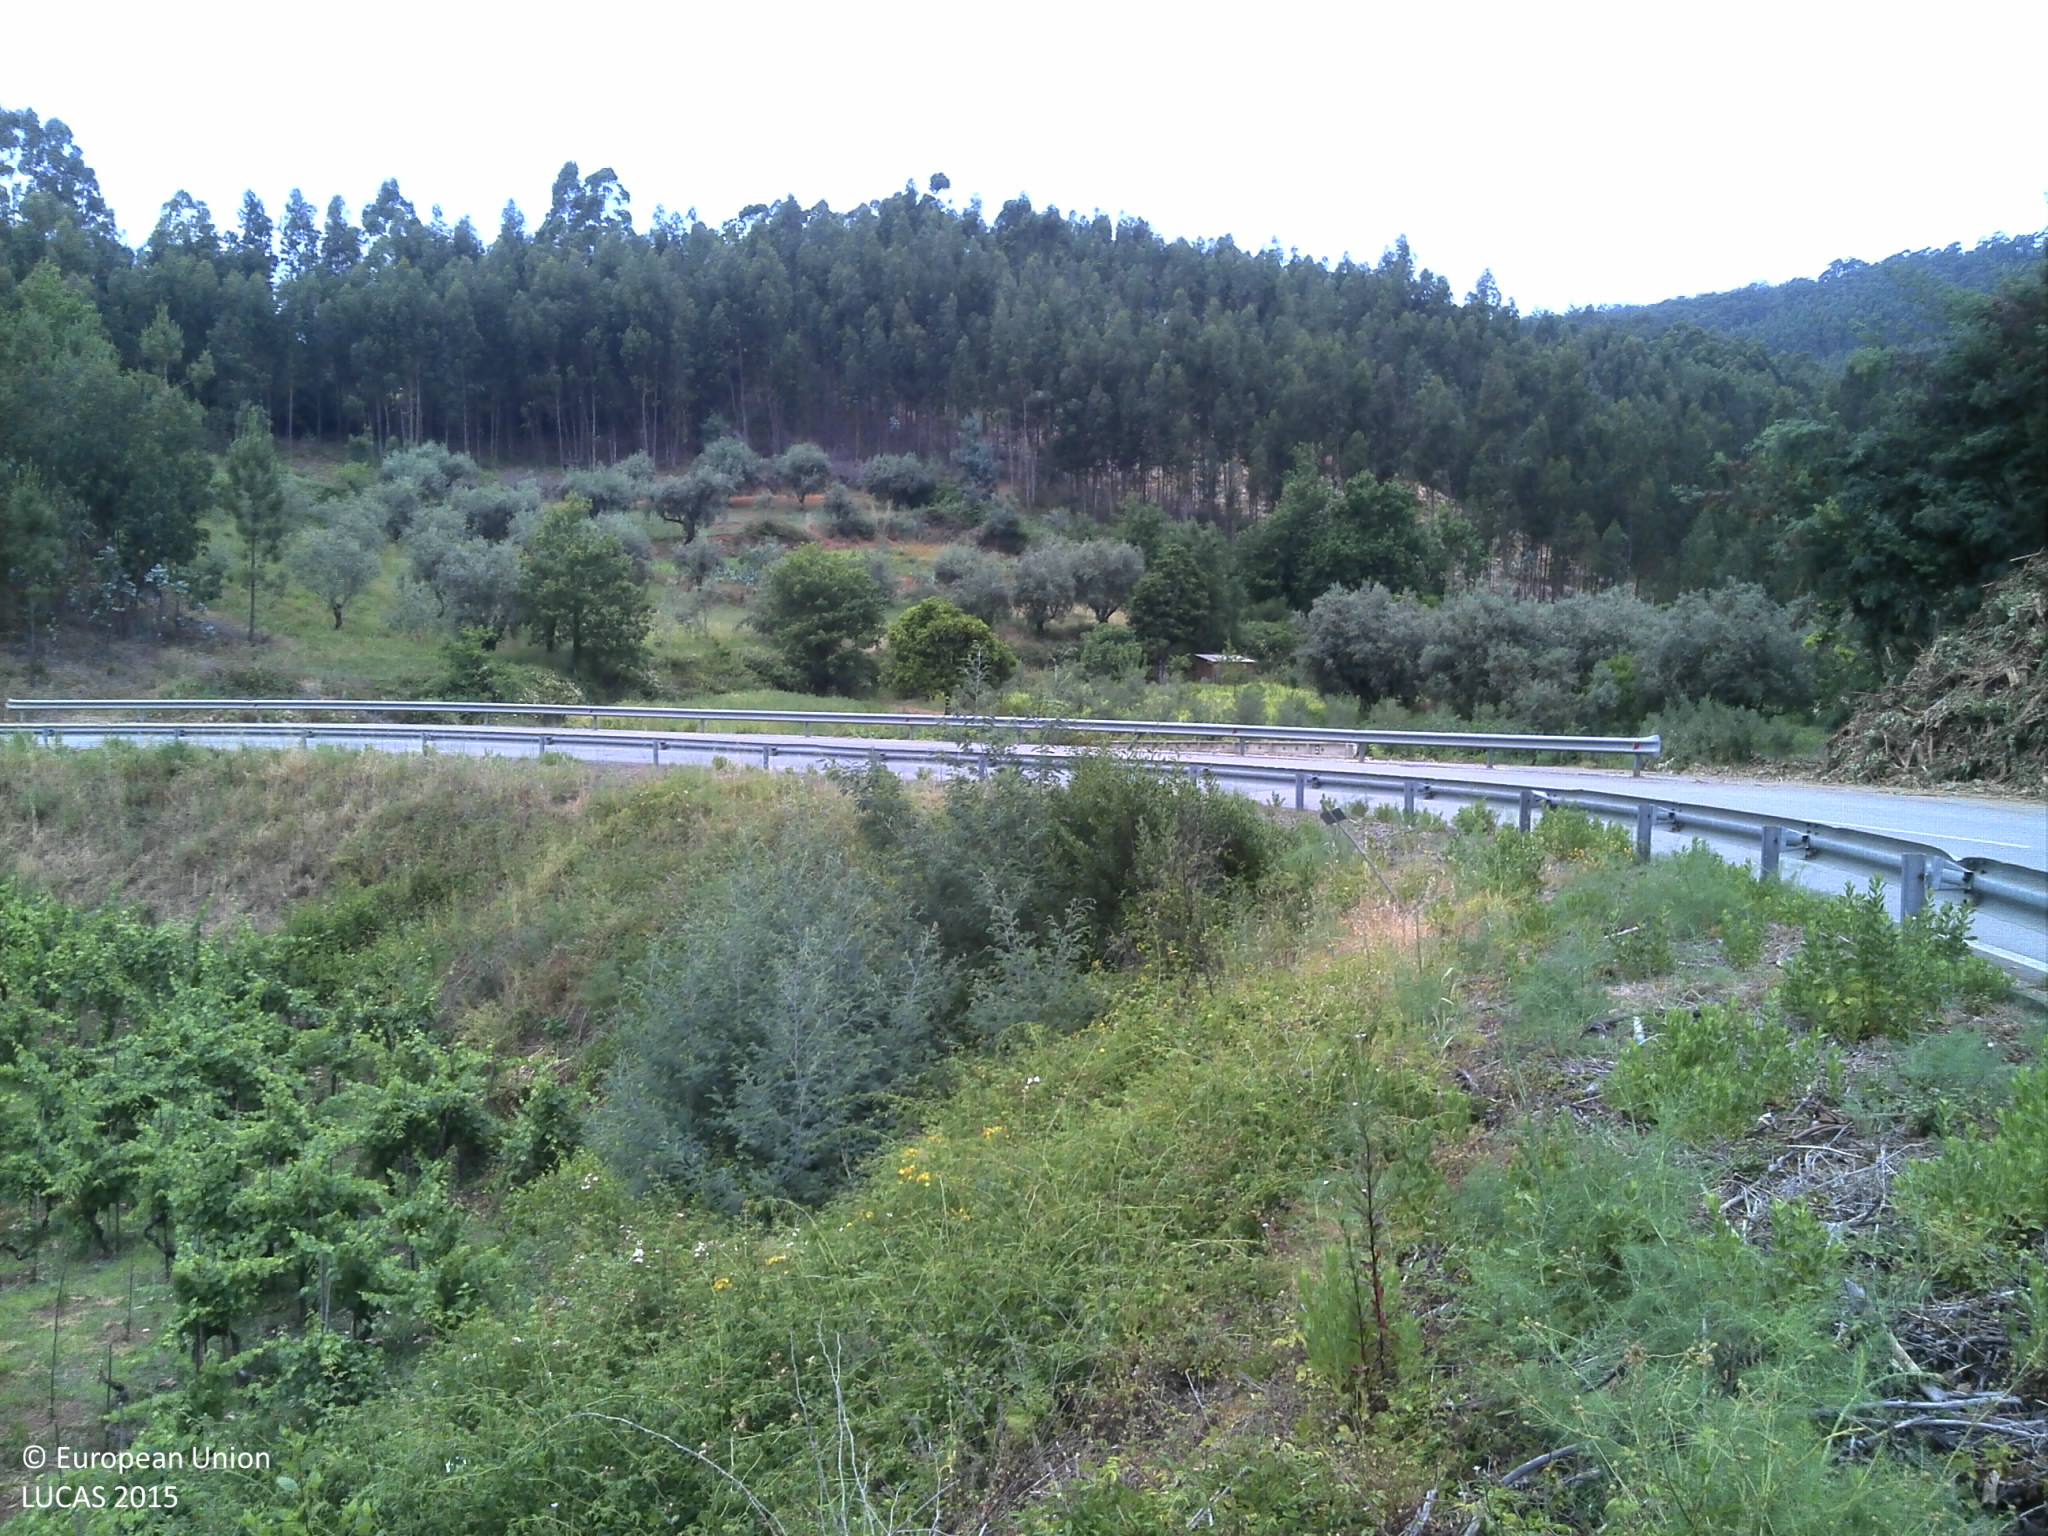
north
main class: Shrubland
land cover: Shrubland without tree cover
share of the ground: > 75 %
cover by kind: shrubs 80 %, unconsolidated bare surface 15 %, herbaceous plants 5 %
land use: Semi-natural and natural areas not in use
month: June
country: PT
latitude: 40.3165
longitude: -8.3346
